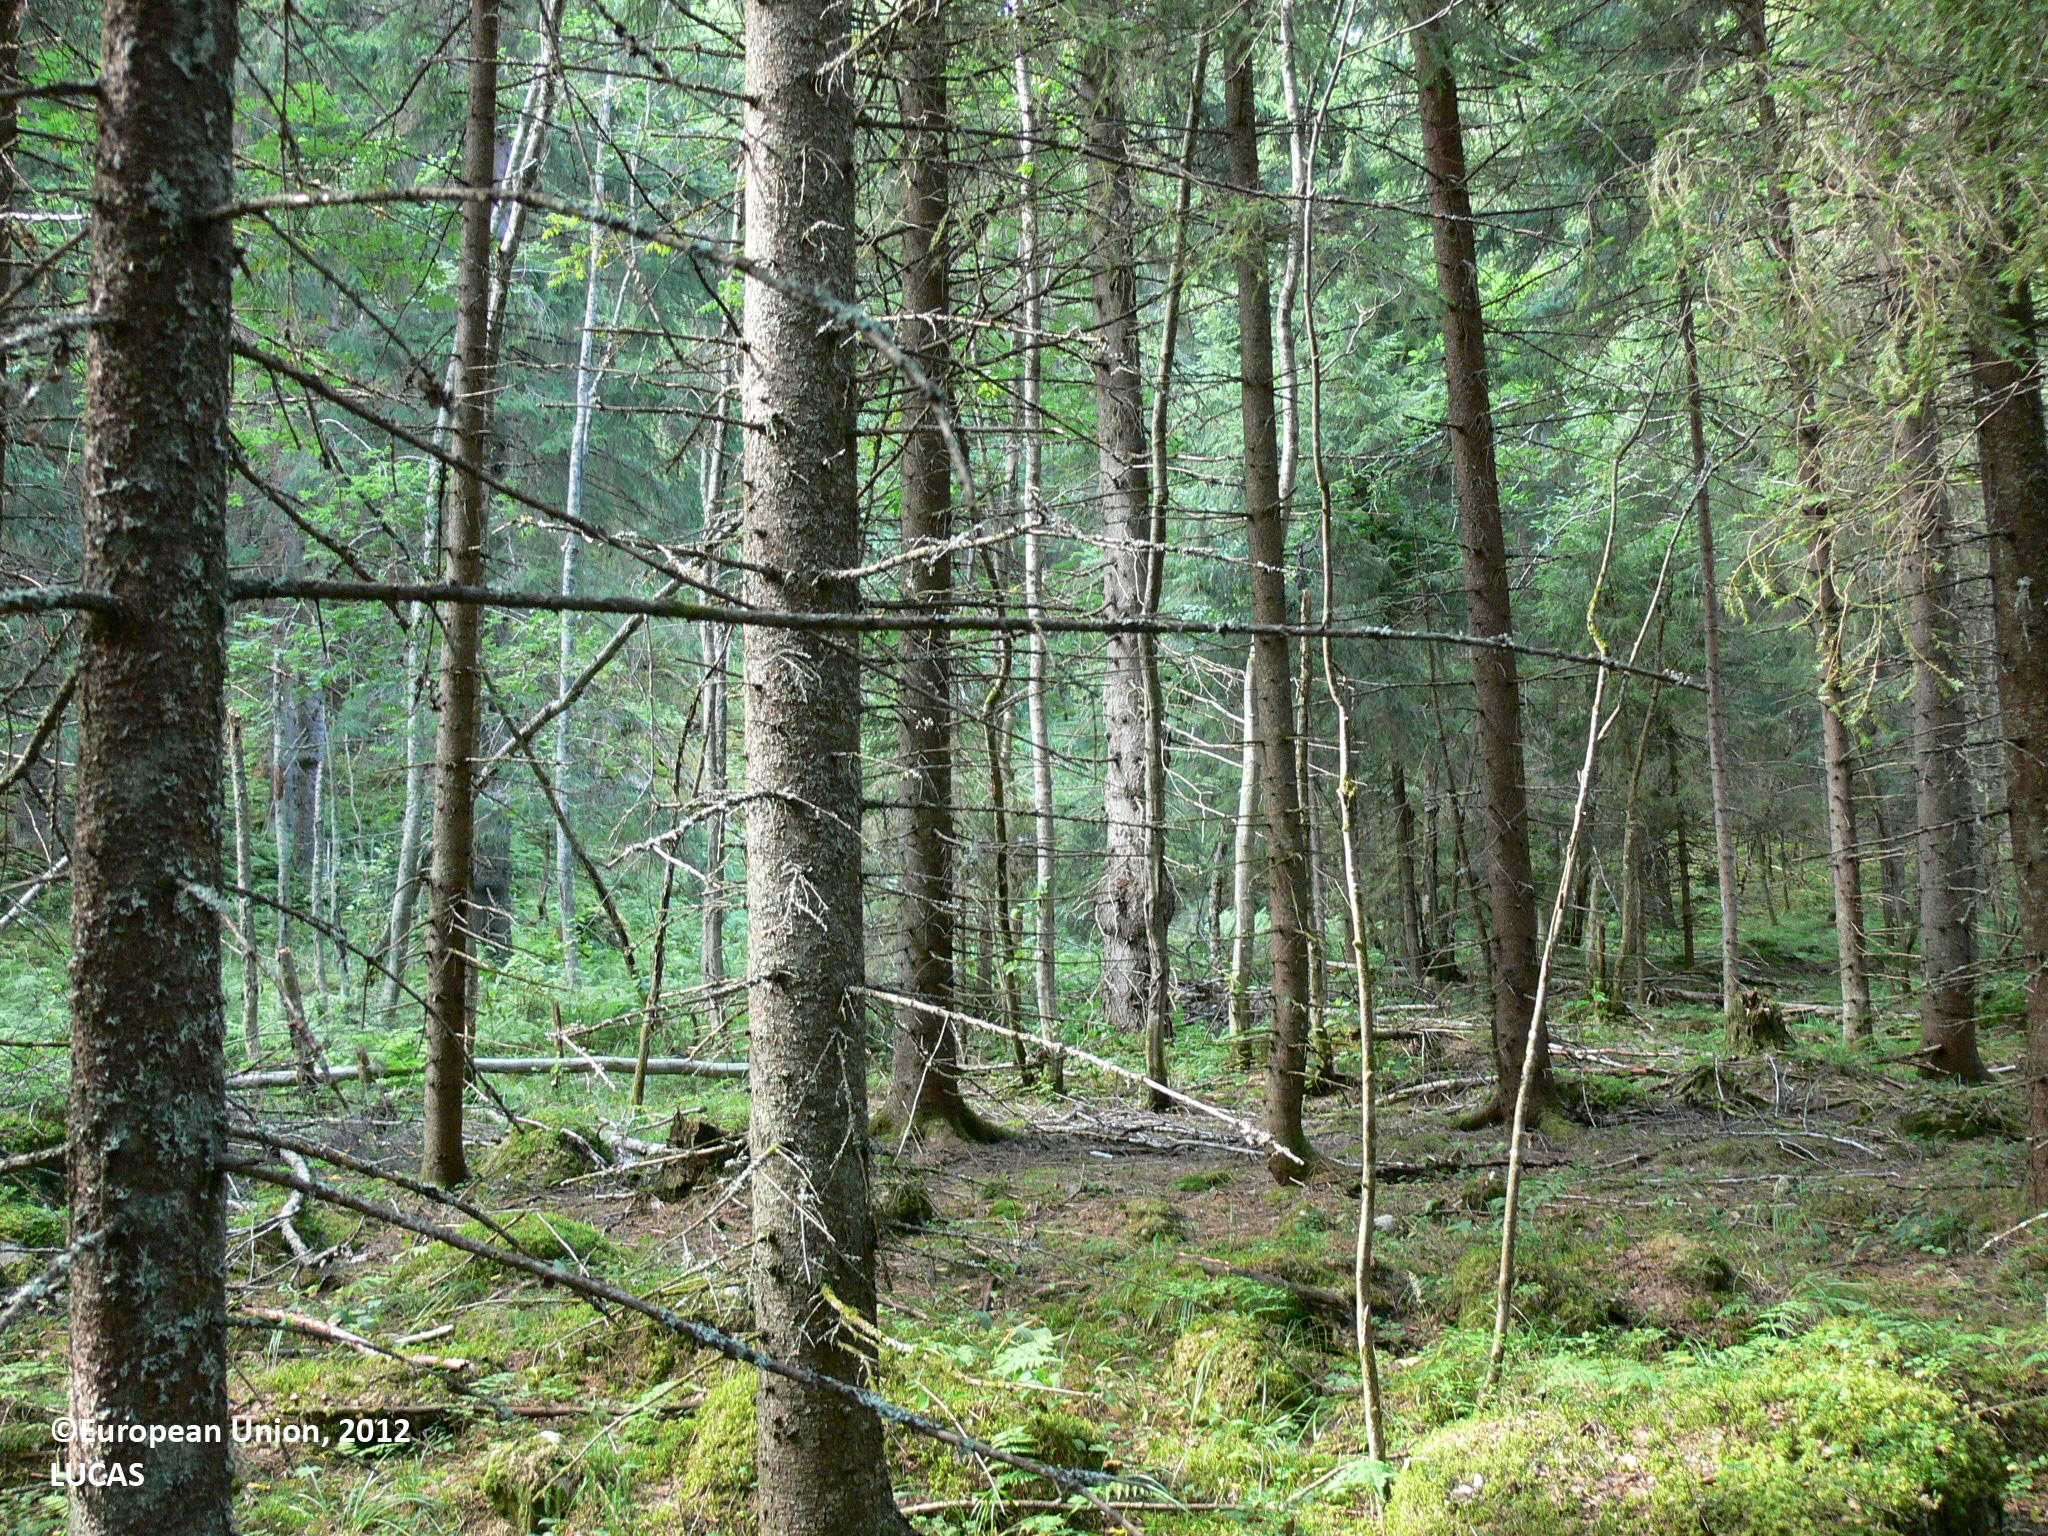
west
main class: Woodland
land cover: Spruce dominated mixed woodland
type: boreal forest
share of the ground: > 75 %
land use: Semi-natural and natural areas not in use
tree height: > 5 m
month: August
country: FI
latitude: 63.0866
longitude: 29.8305
